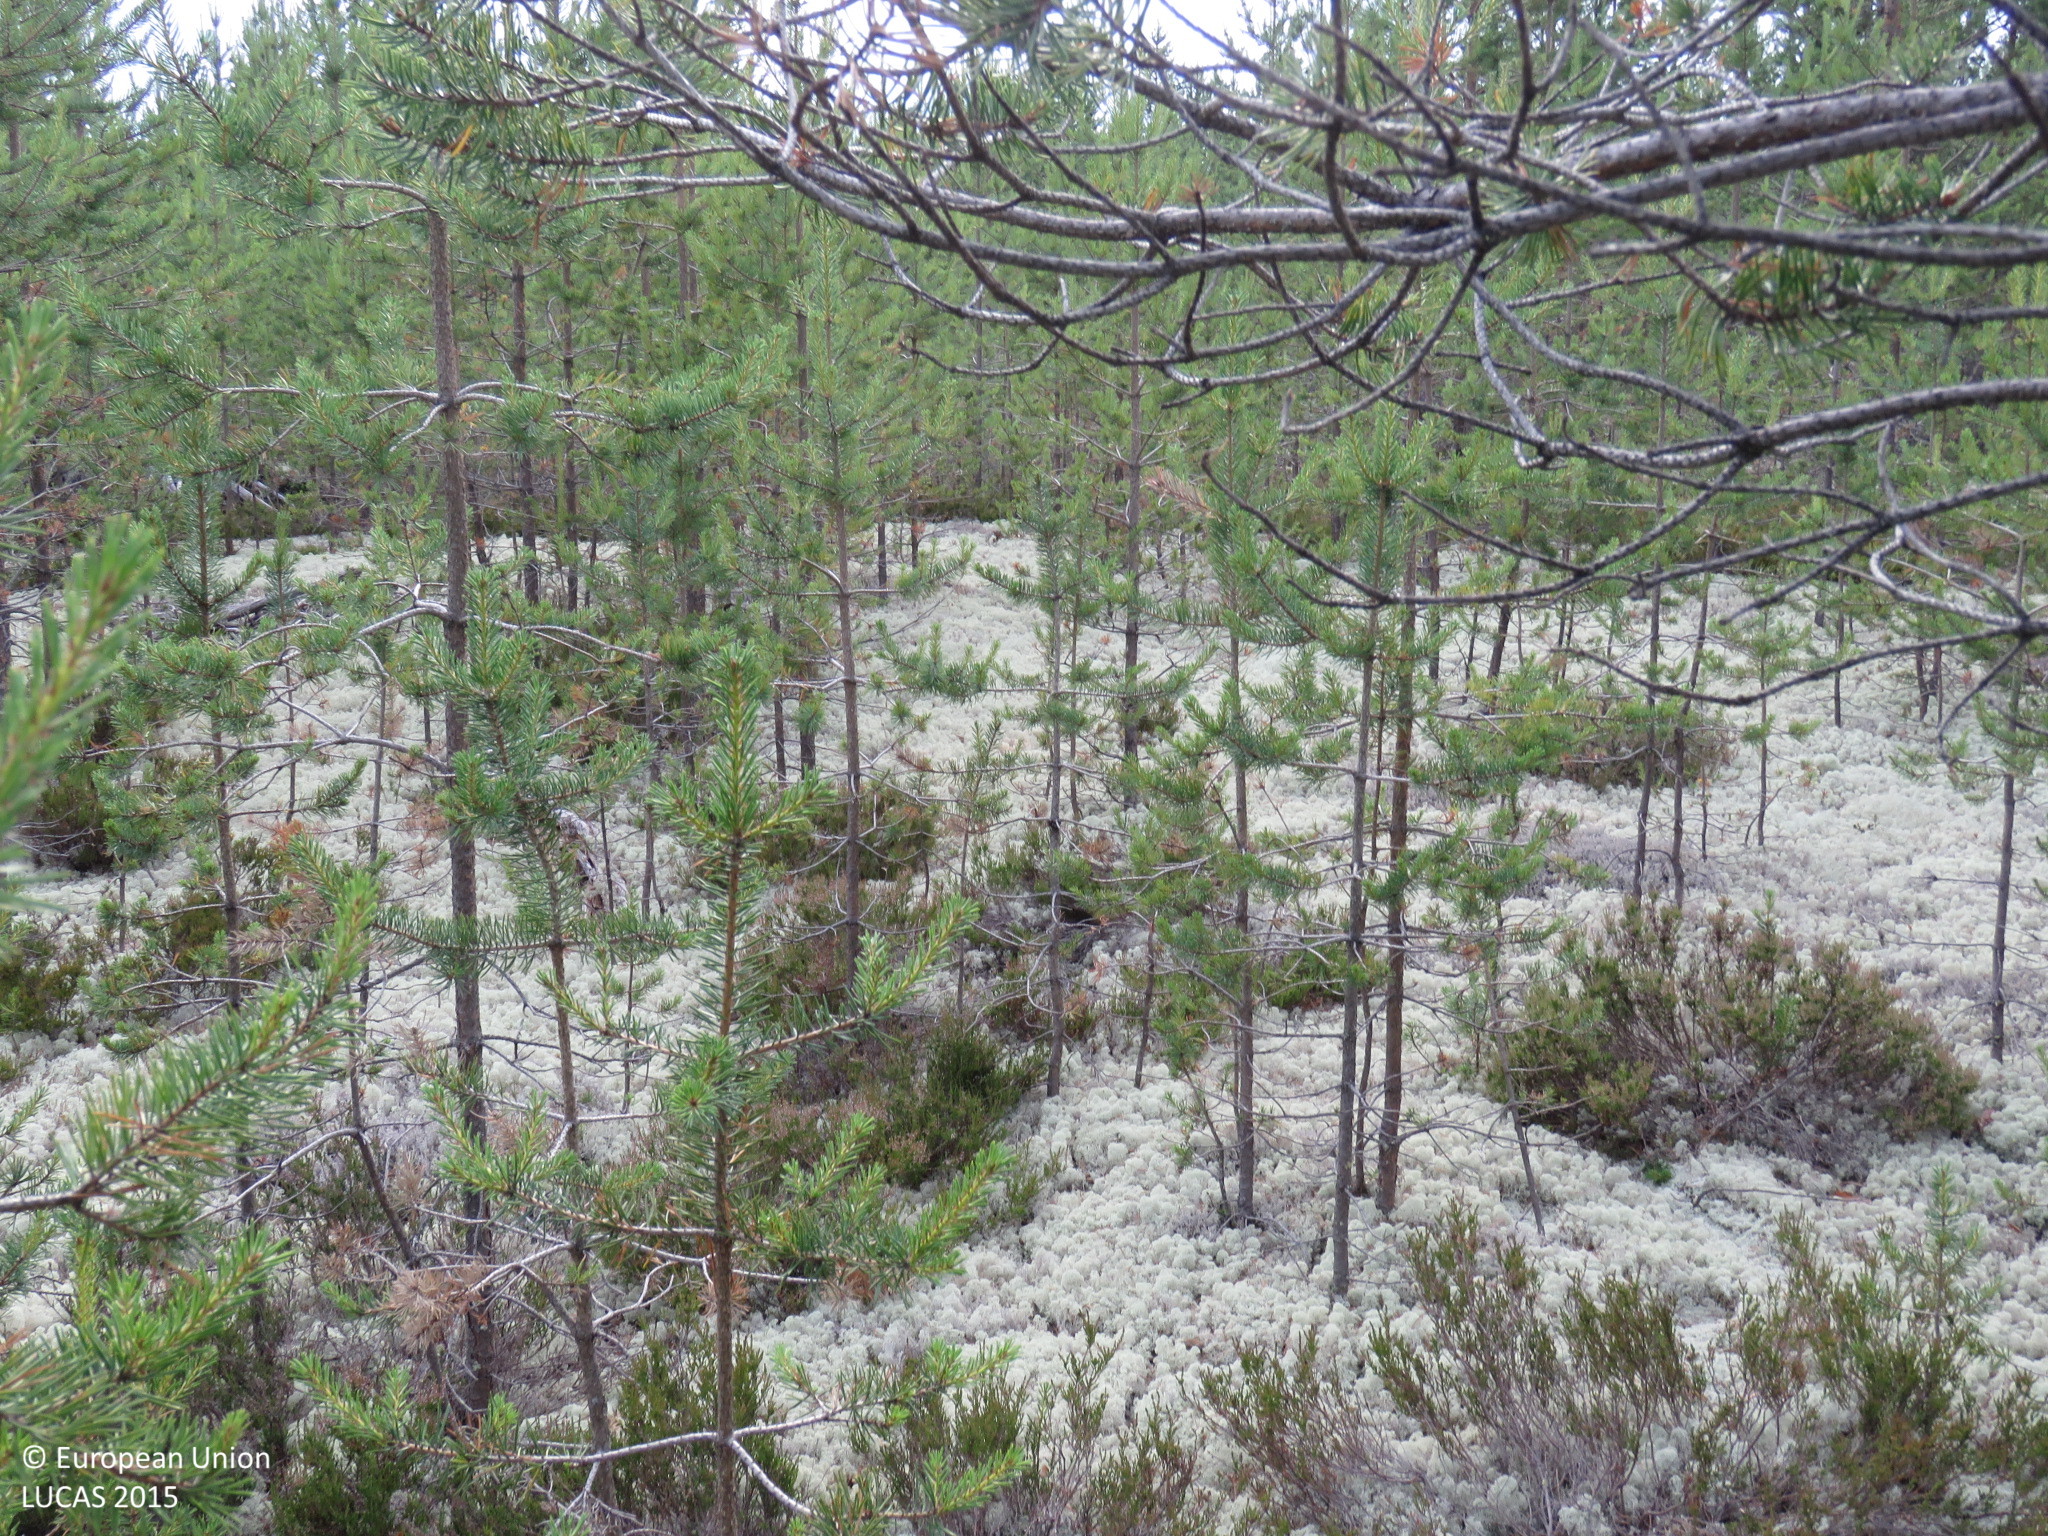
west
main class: Woodland
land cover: Pine dominated coniferous woodland
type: boreal forest
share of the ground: > 75 %
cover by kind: coniferous forest trees 75 %, lichens and mosses 20 %, shrubs 5 %
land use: Forestry
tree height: > 5 m
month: July
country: FI
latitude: 64.6077
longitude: 26.4350
